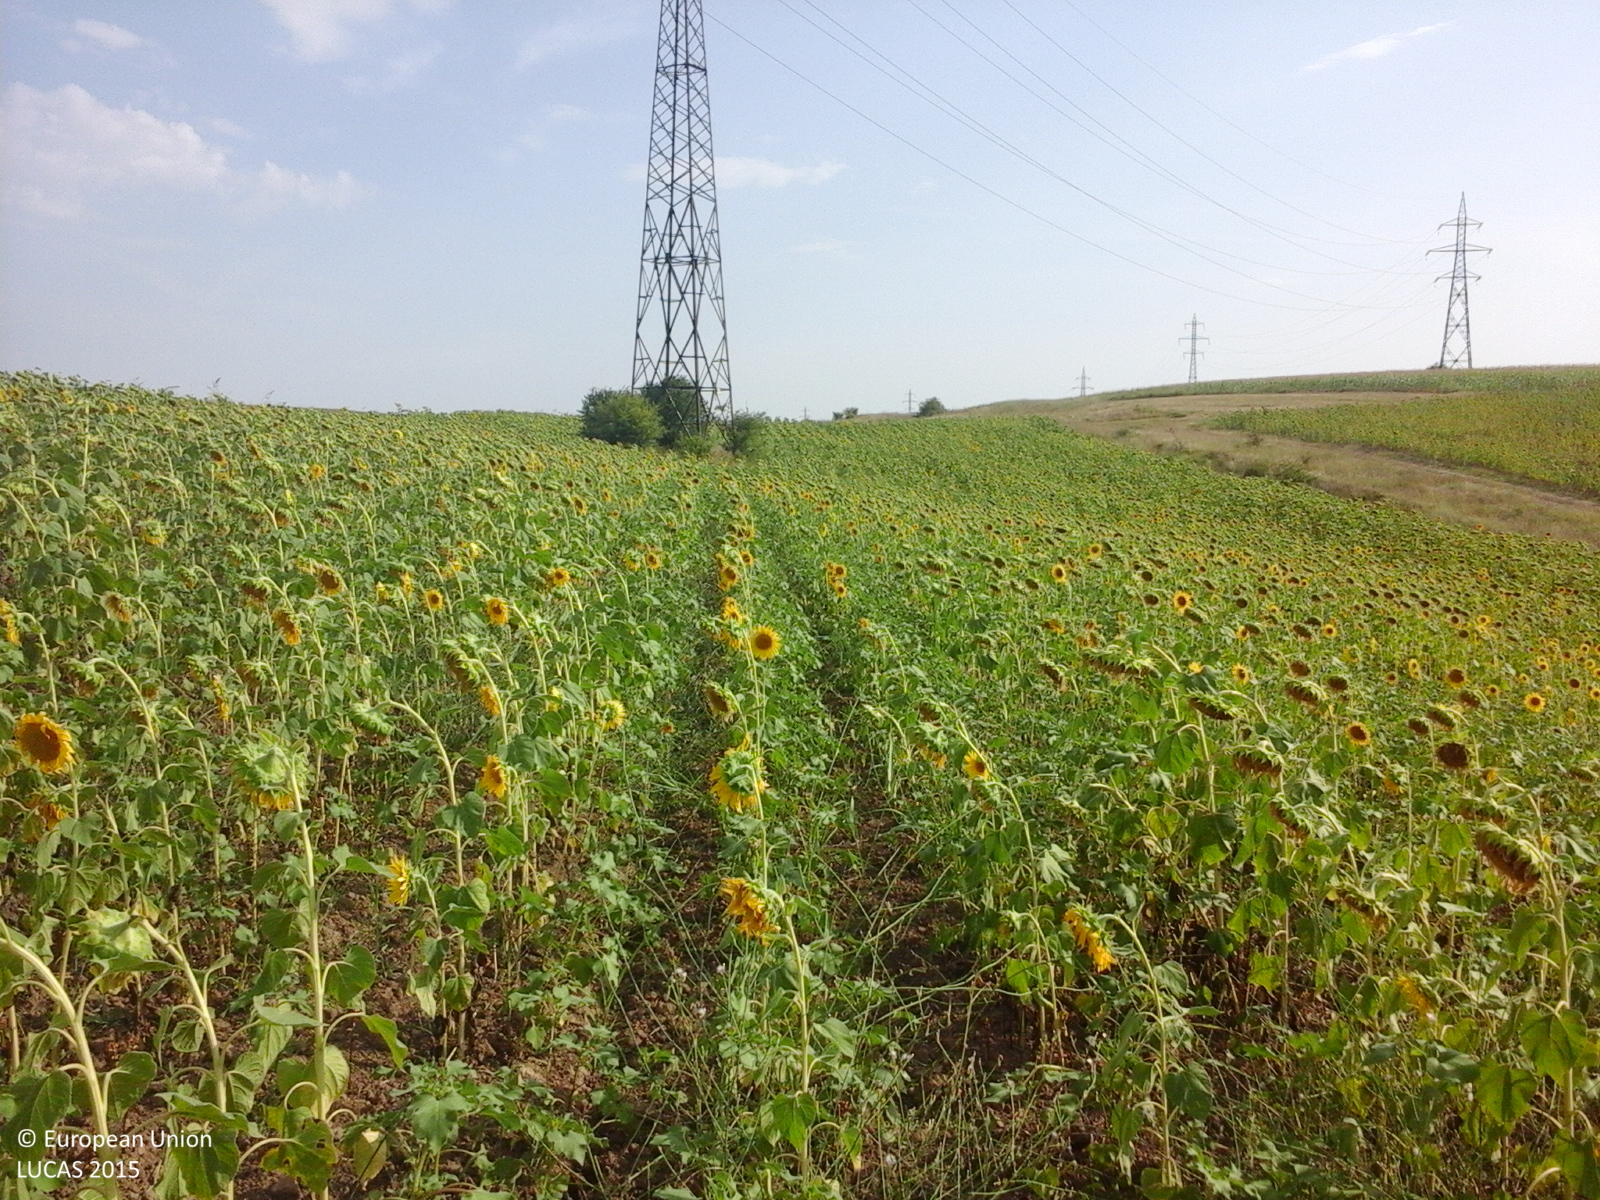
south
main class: Cropland
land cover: Sunflower
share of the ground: > 75 %
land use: Agriculture (excluding fallow land and kitchen gardens)
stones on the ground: < 10 %
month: August
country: RO
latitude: 44.2104
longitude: 27.9366
